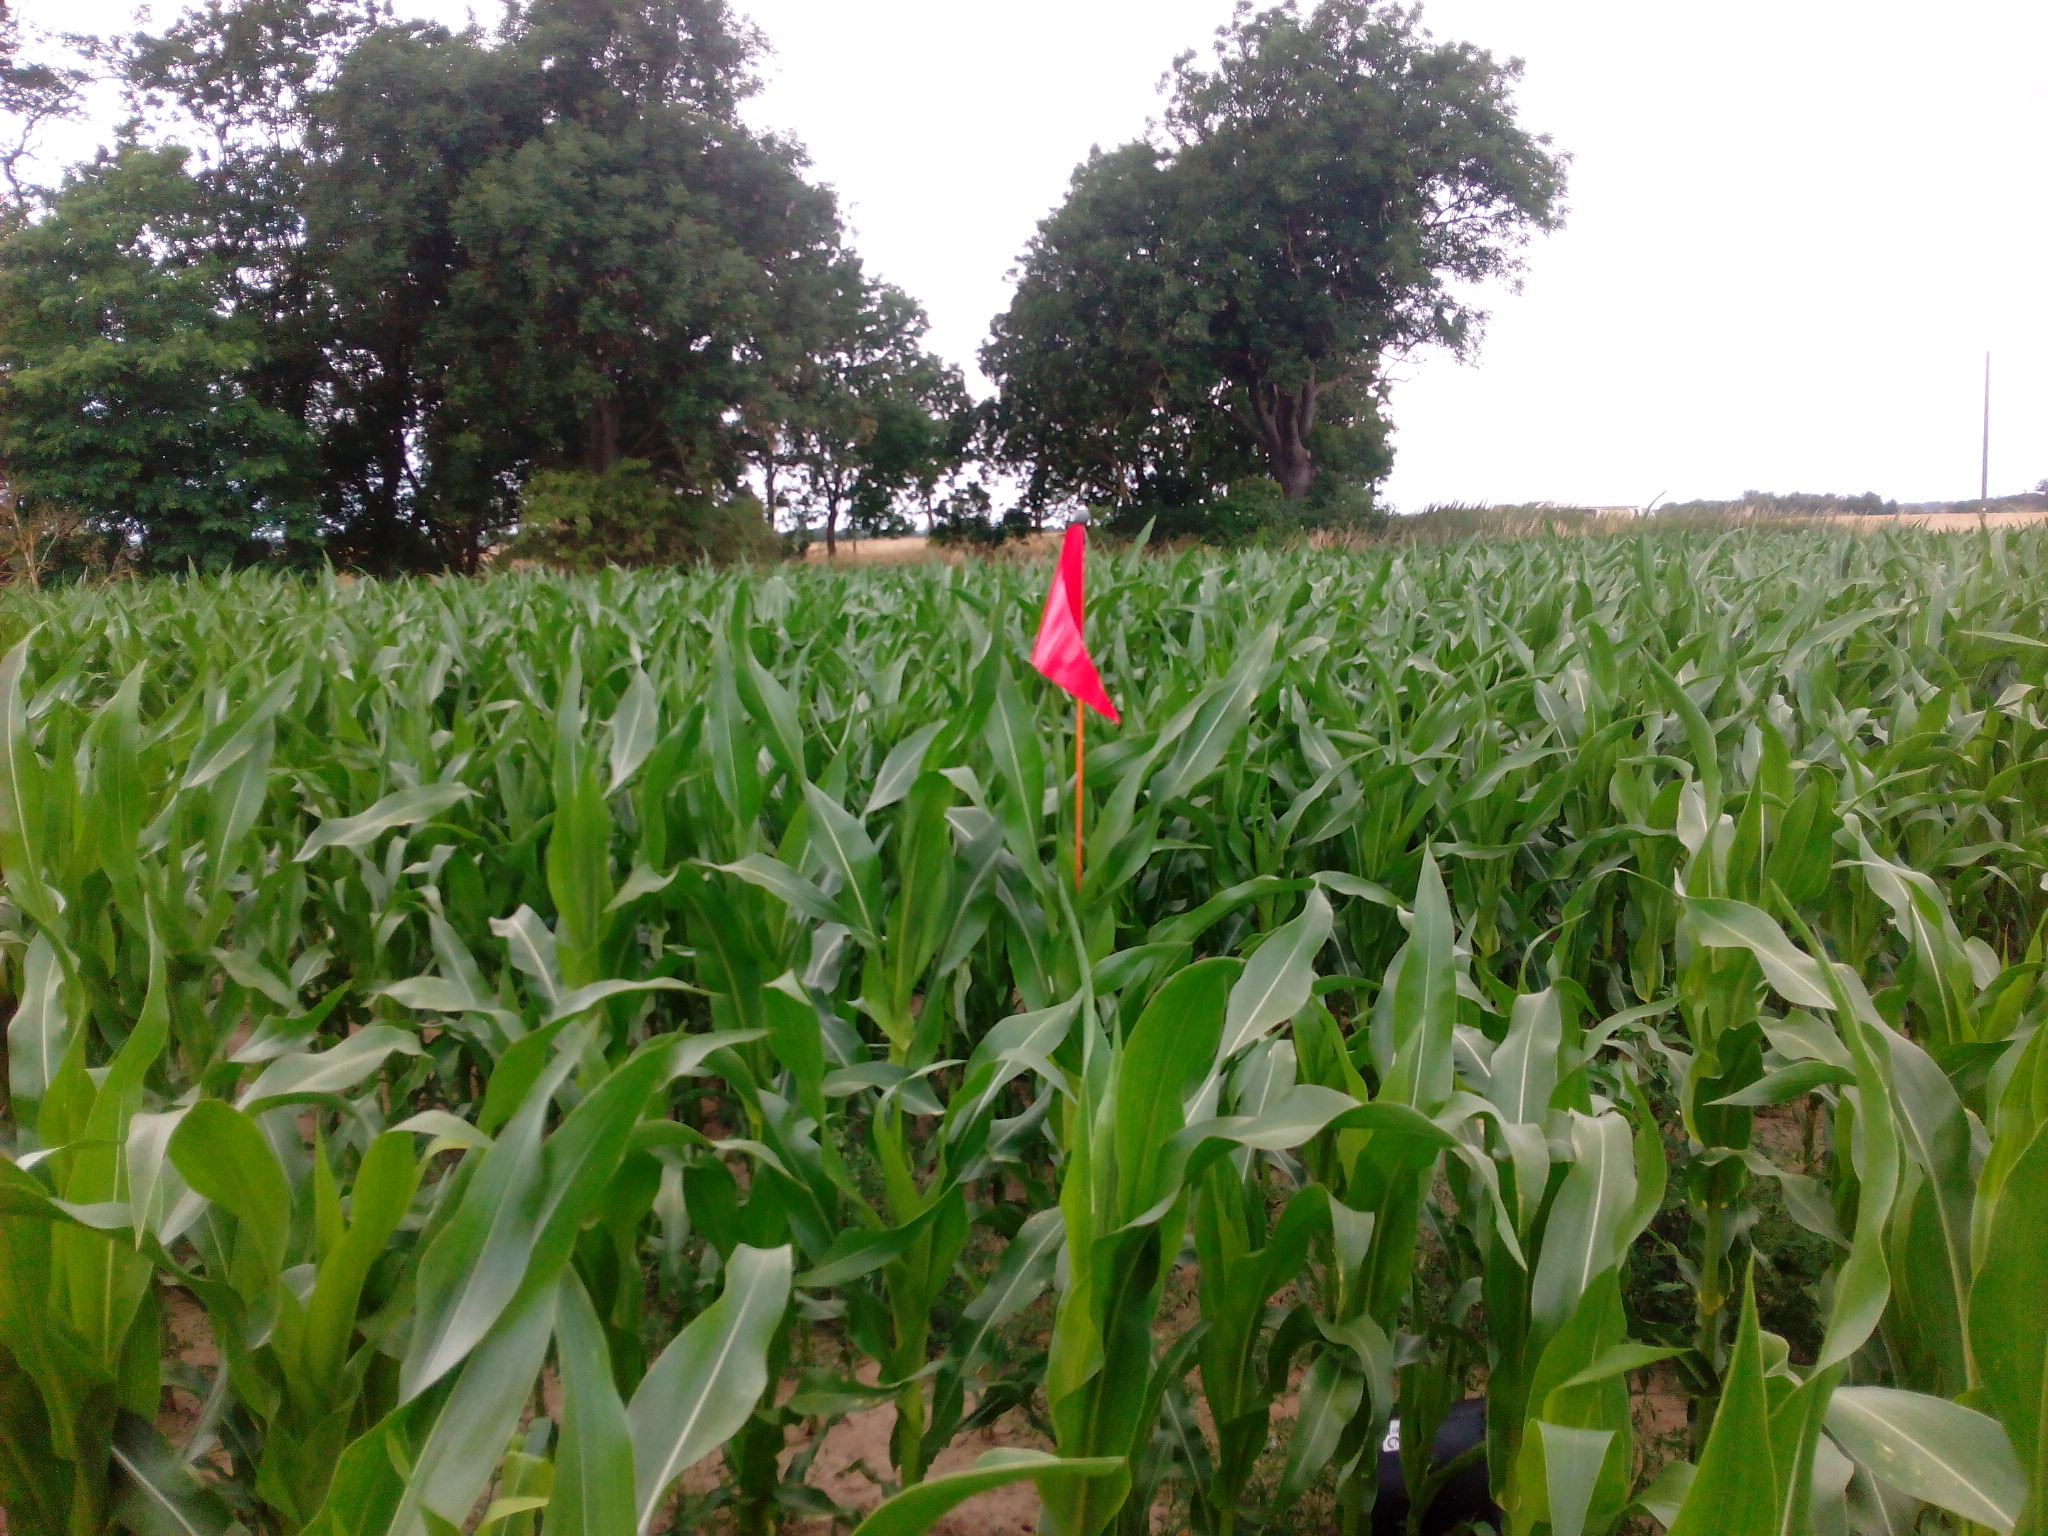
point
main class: Cropland
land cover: Maize
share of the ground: 50 - 75 %
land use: Agriculture (excluding fallow land and kitchen gardens)
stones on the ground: < 10 %
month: July
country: DE
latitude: 53.3981
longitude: 14.2870
